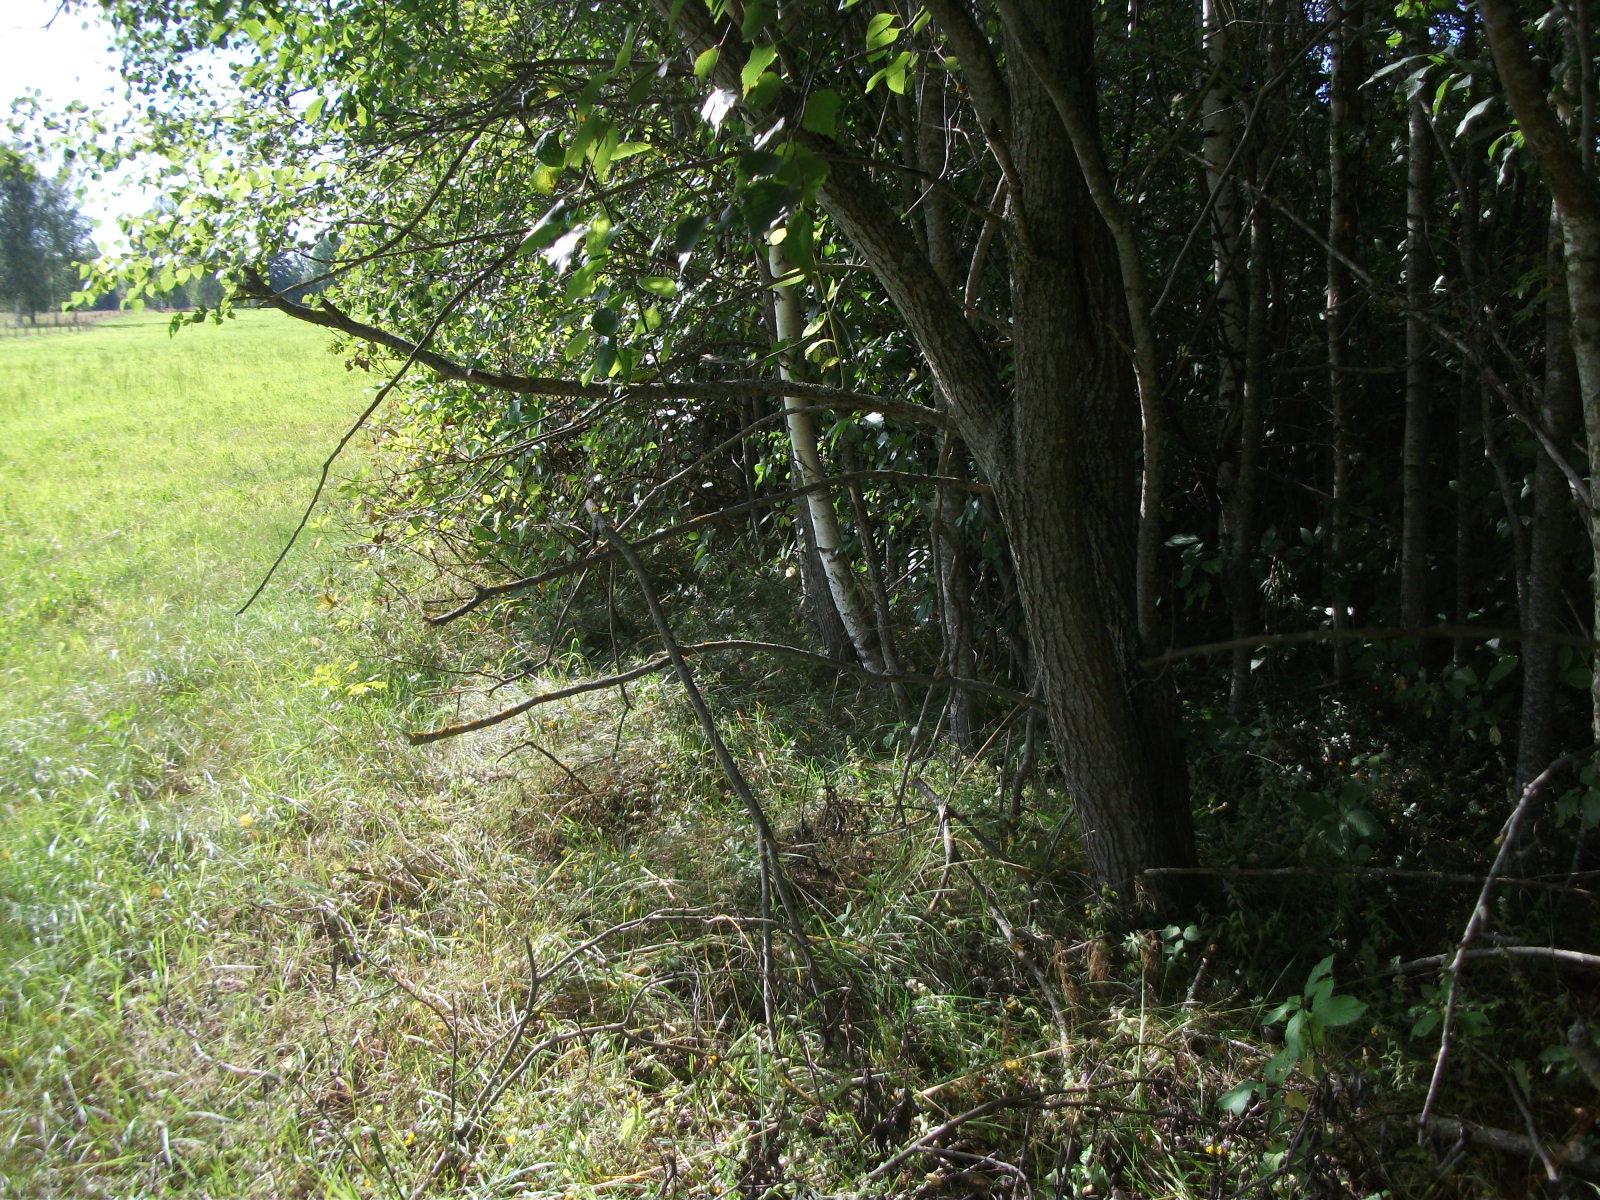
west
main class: Grassland
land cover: Grassland without tree/shrub cover
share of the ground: > 75 %
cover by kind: herbaceous plants 100 %
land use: Agriculture (excluding fallow land and kitchen gardens)
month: August
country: LV
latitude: 56.4873
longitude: 26.3677
